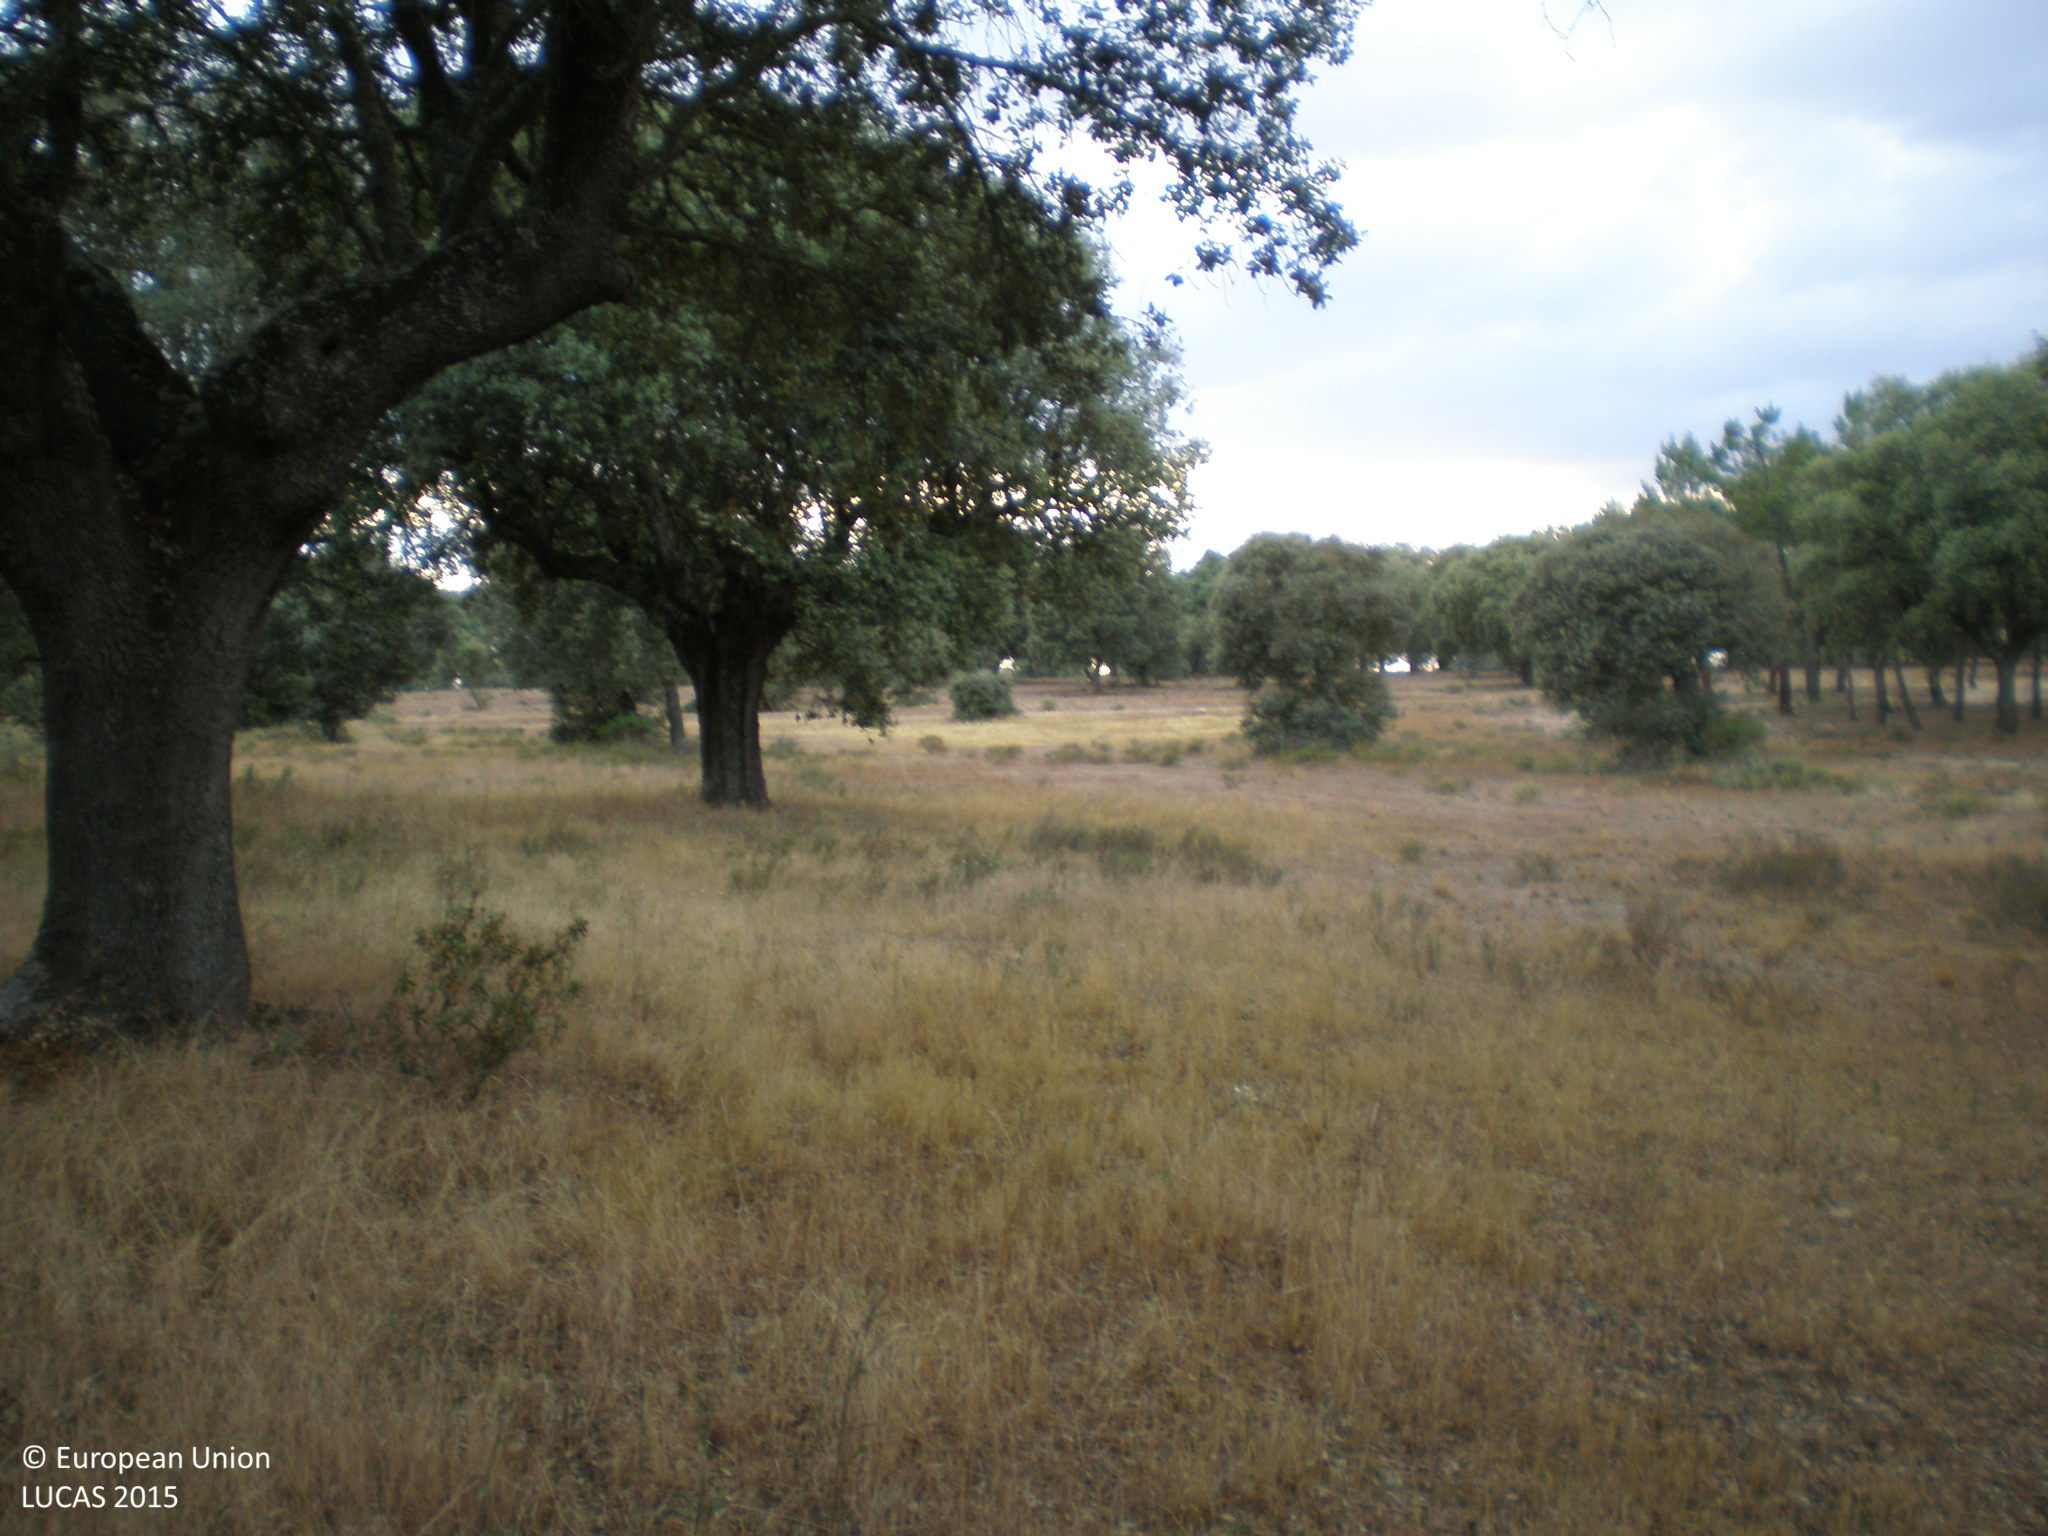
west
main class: Woodland
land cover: Broadleaved woodland
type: broadleaved evergreen forest
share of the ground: 50 - 75 %
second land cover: Grassland without tree/shrub cover
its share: 25 - 50 %
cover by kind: broadleaved forest trees 60 %, herbaceous plants 40 %
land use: Forestry
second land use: Agriculture (excluding fallow land and kitchen gardens)
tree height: > 5 m
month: June
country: ES
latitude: 41.1301
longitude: -5.7941
